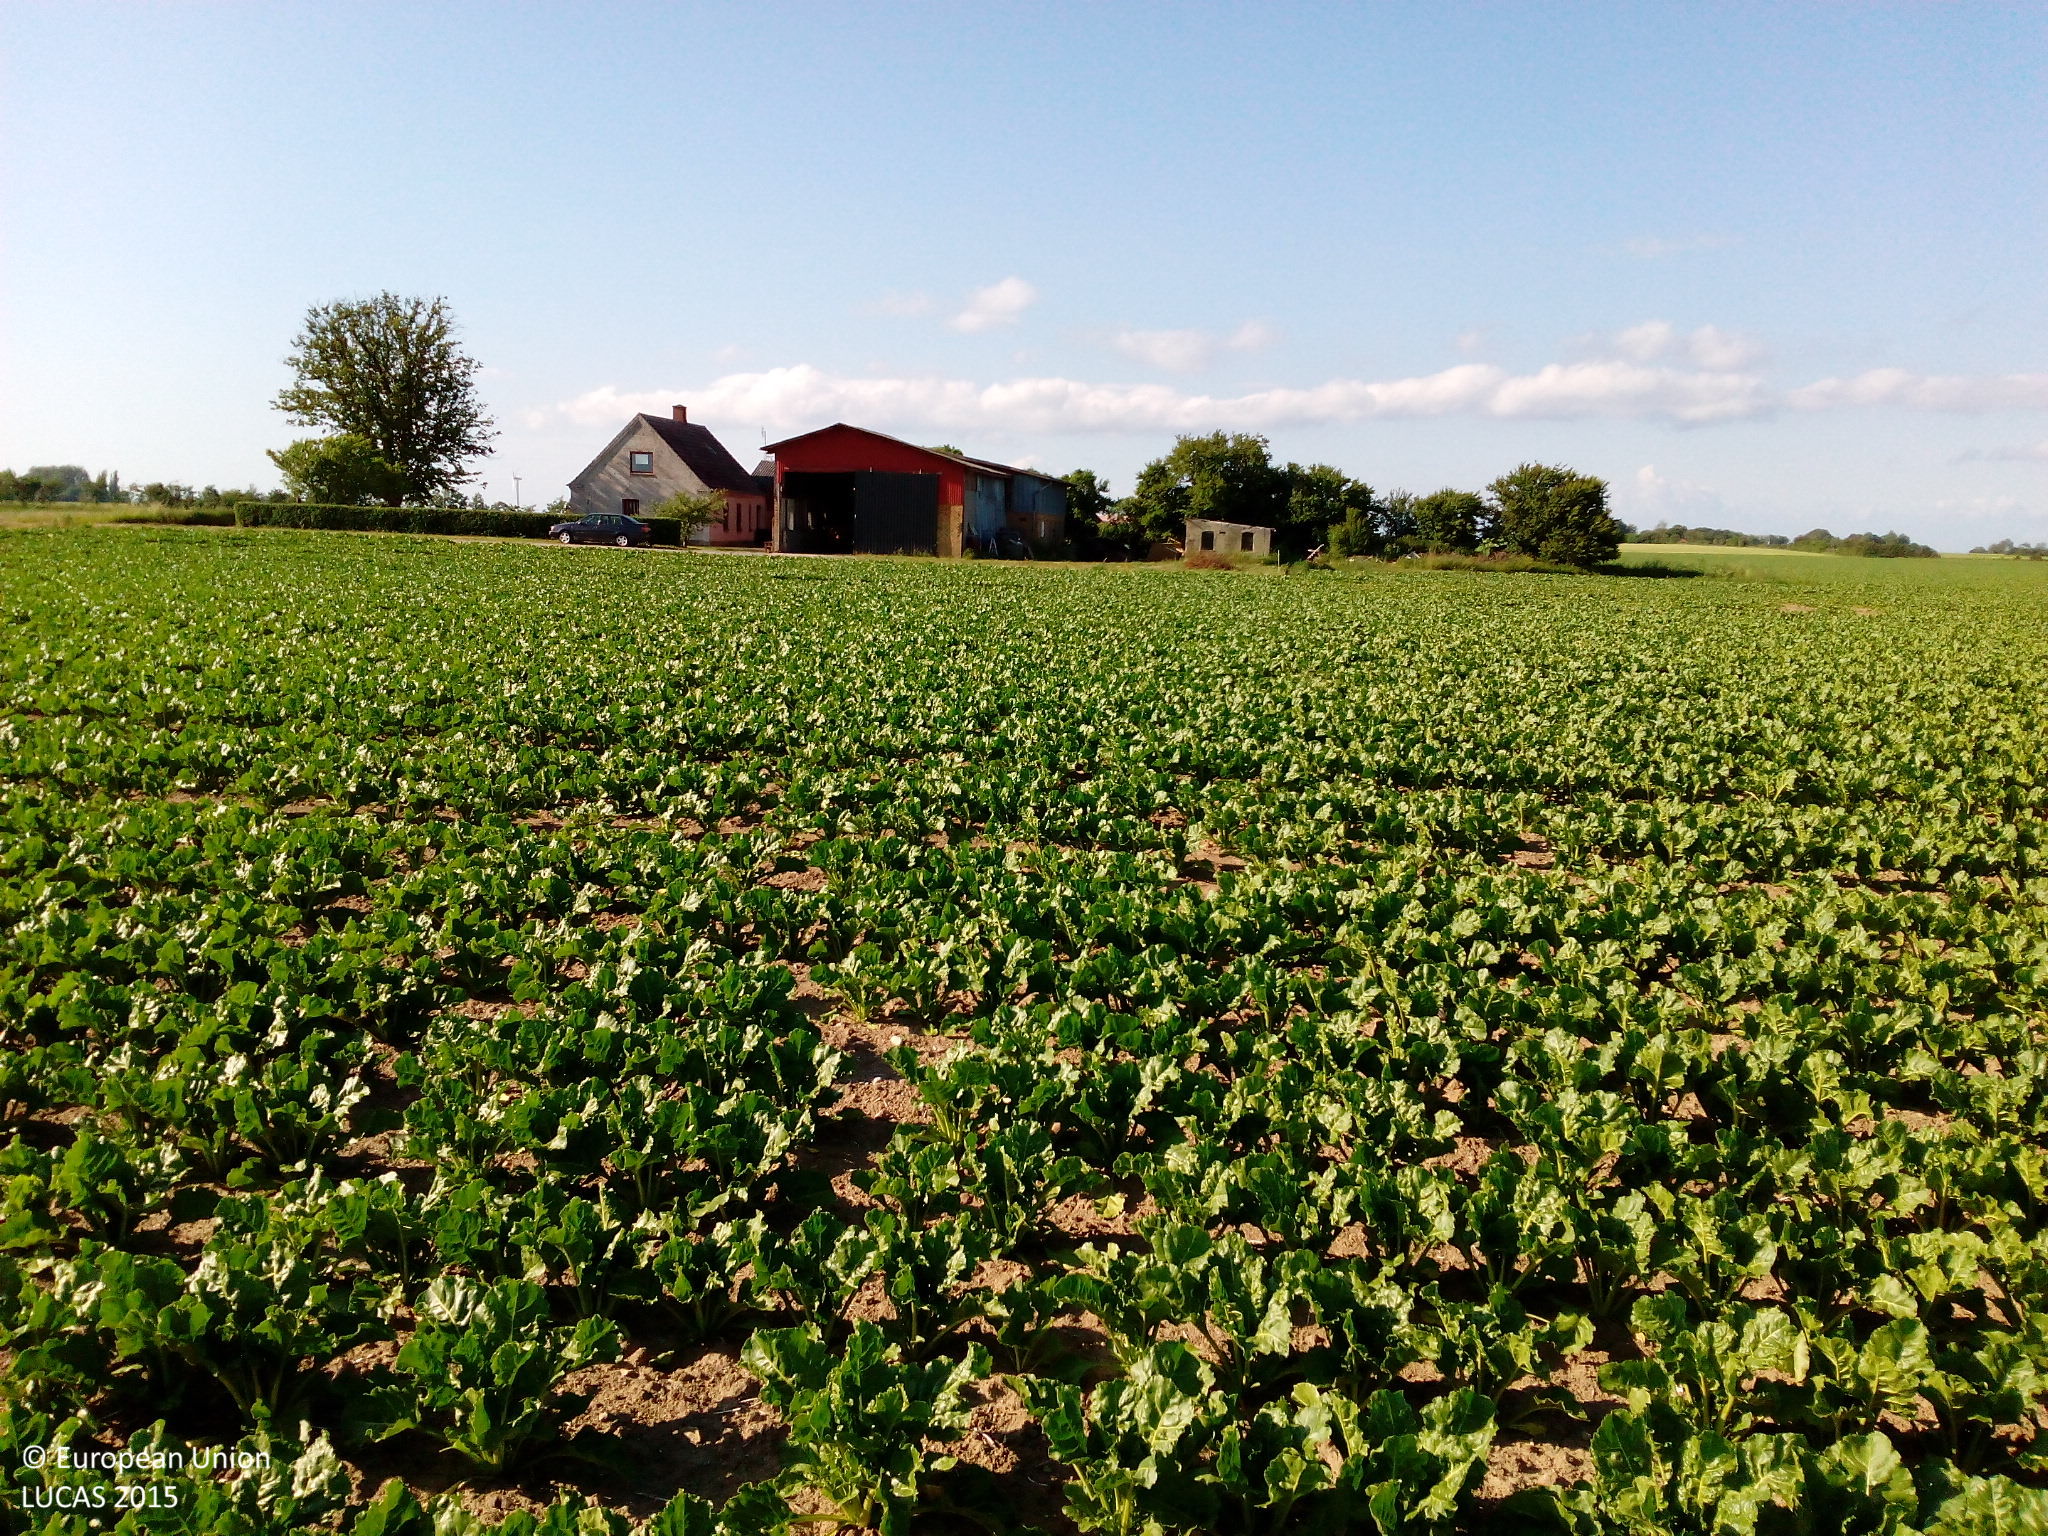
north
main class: Cropland
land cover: Sugar beet
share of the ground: > 75 %
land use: Agriculture (excluding fallow land and kitchen gardens)
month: June
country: DK
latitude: 54.9415
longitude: 11.2323
